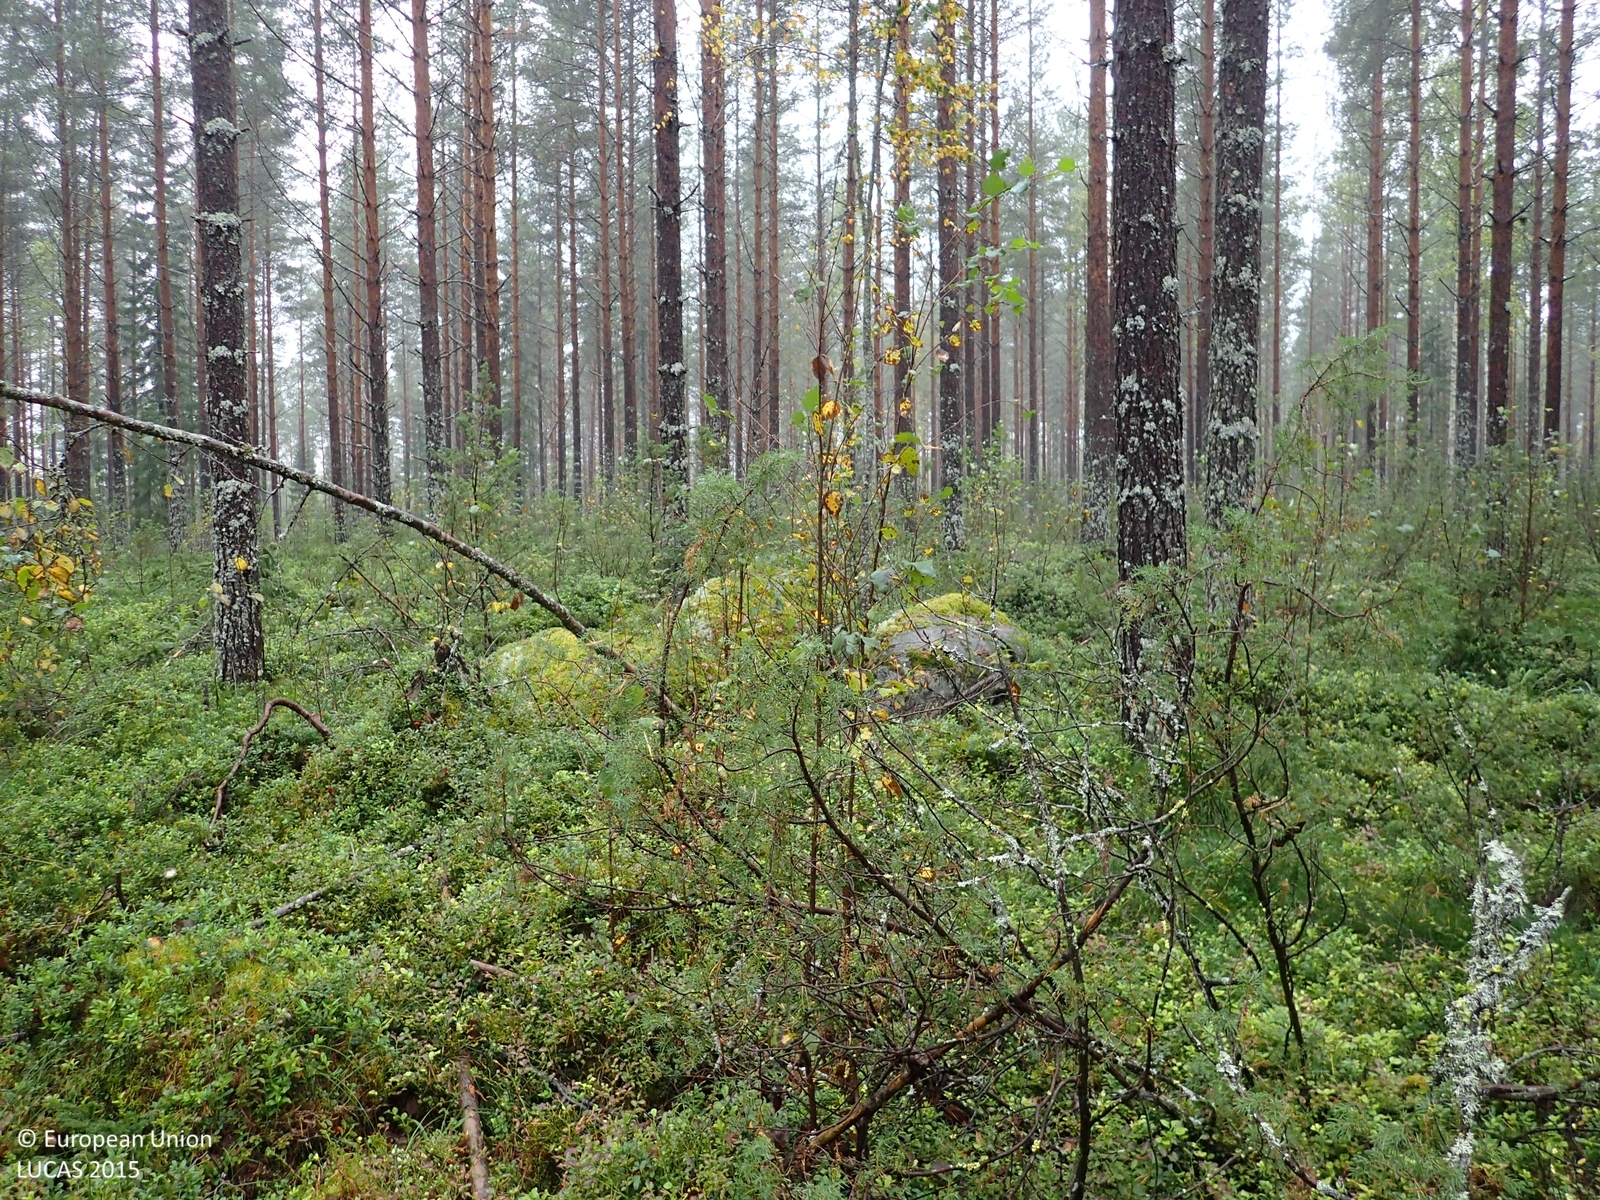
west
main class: Woodland
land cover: Other coniferous woodland
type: boreal forest
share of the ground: > 75 %
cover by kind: coniferous forest trees 70 %, shrubs 20 %, broadleaved forest trees 5 %, herbaceous plants 5 %
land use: Forestry
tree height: > 5 m
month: September
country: FI
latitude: 63.2464
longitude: 25.4549
